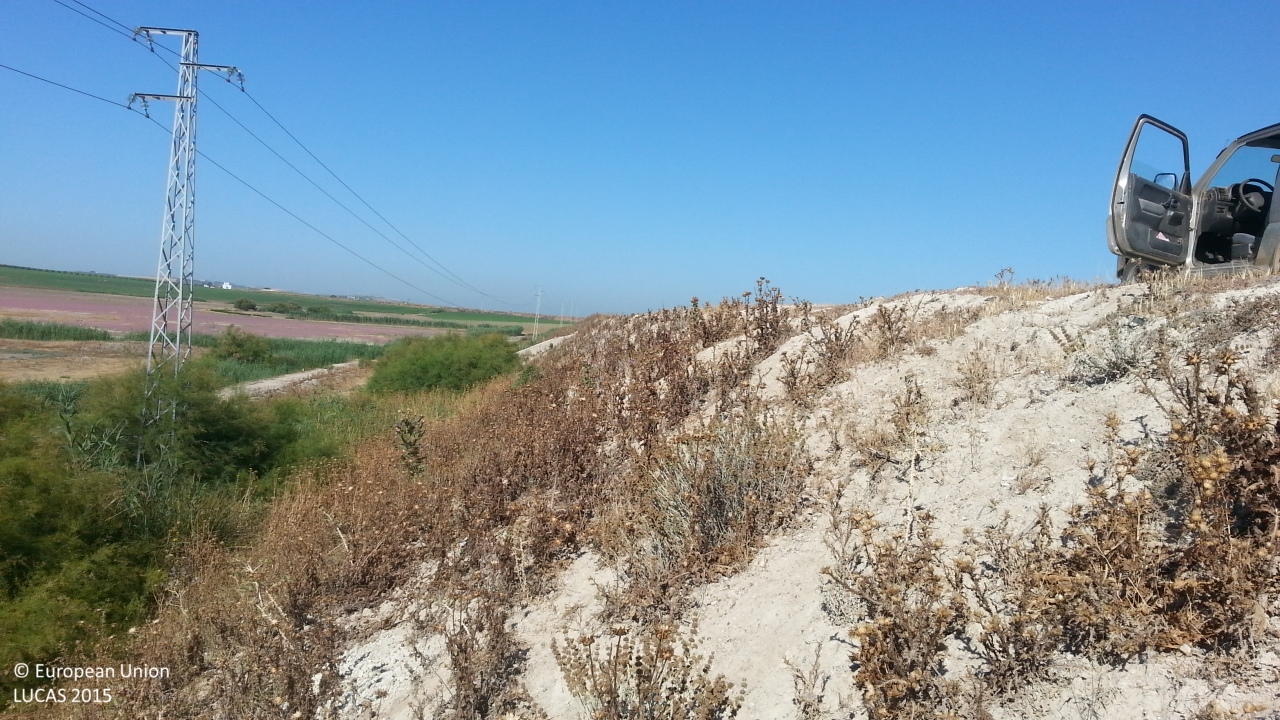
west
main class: Shrubland
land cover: Shrubland without tree cover
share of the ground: 50 - 75 %
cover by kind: shrubs 50 %, unconsolidated bare surface 45 %, herbaceous plants 5 %
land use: Agriculture (excluding fallow land and kitchen gardens)
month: June
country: ES
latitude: 36.9948
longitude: -5.9827
